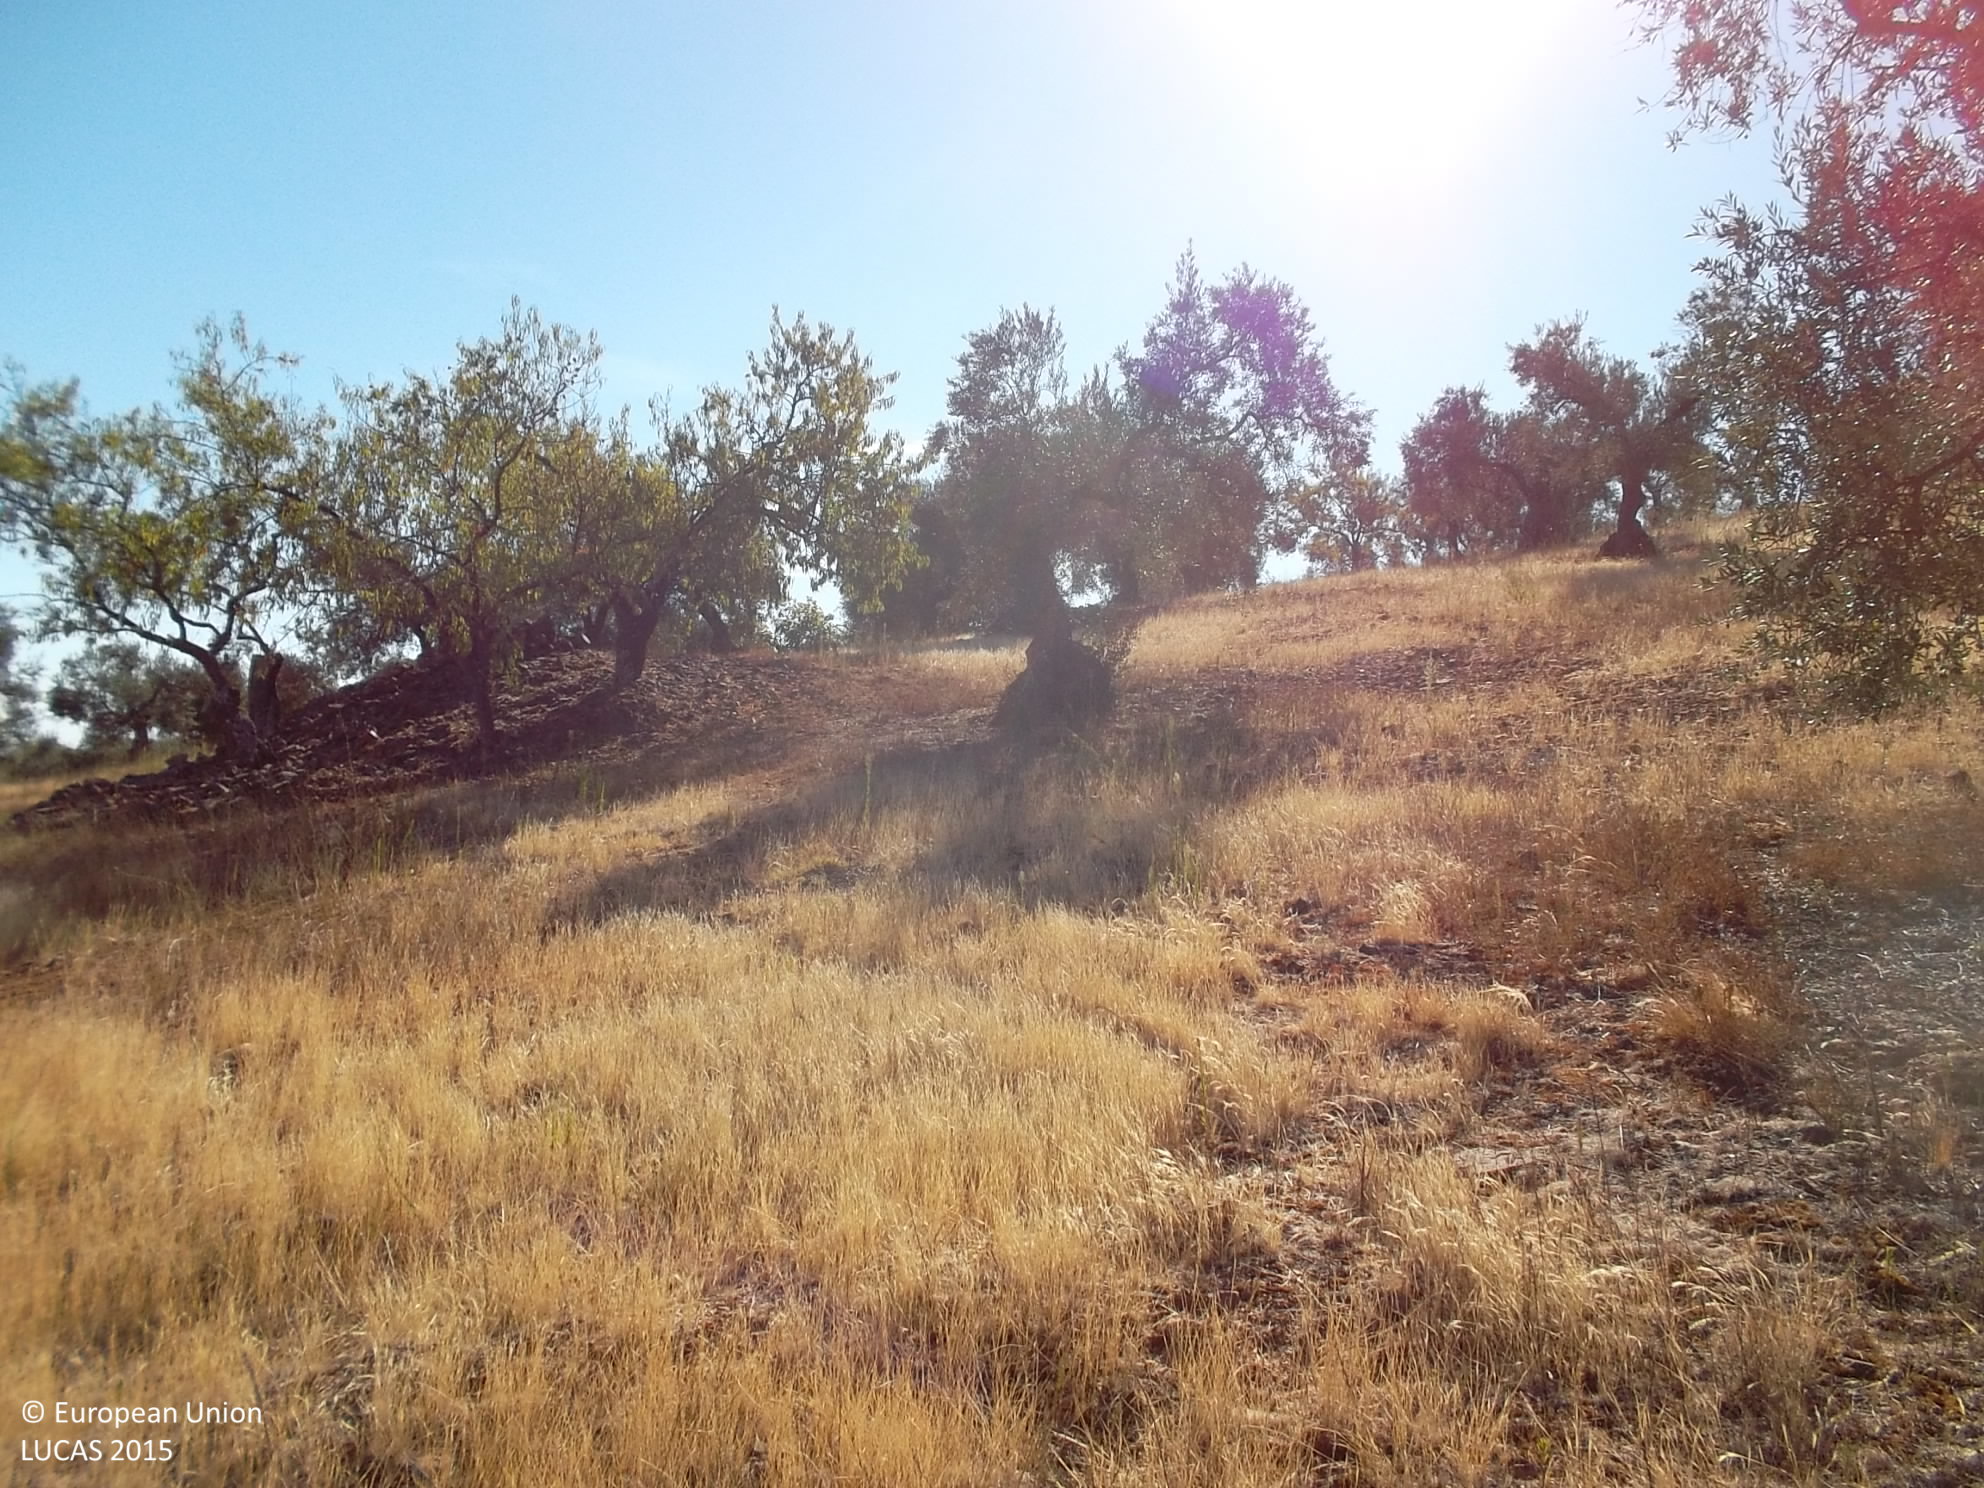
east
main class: Cropland
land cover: Olive groves
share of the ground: 25 - 50 %
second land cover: Grassland without tree/shrub cover
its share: > 75 %
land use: Agriculture (excluding fallow land and kitchen gardens)
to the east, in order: Olive groves; Grassland without tree/shrub cover; Rock outcrops; Olive groves; Rock outcrops; Olive groves; Rock outcrops; Olive groves
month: August
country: ES
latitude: 38.5135
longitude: -6.5813
